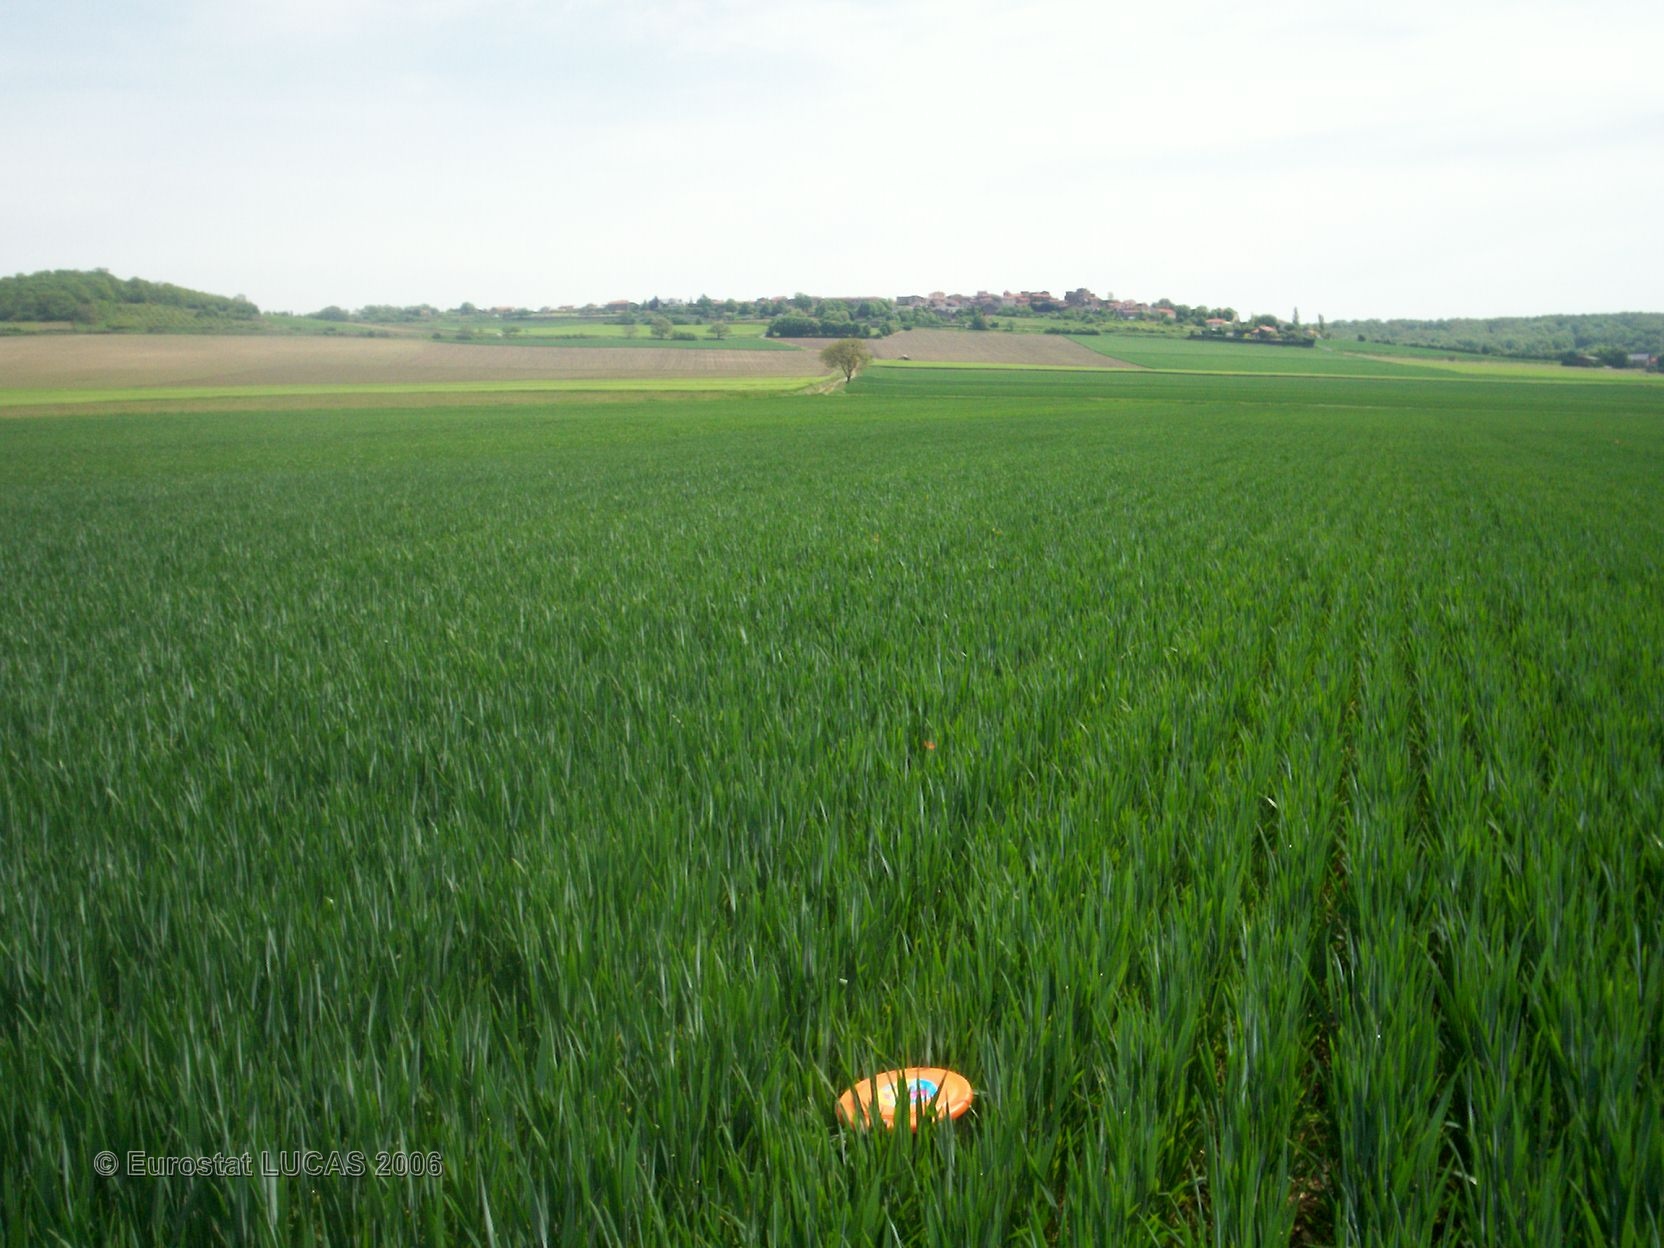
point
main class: Cropland
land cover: Common wheat
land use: Agriculture (excluding fallow land and kitchen gardens)
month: May
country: FR
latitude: 45.5024
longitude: 3.2051
